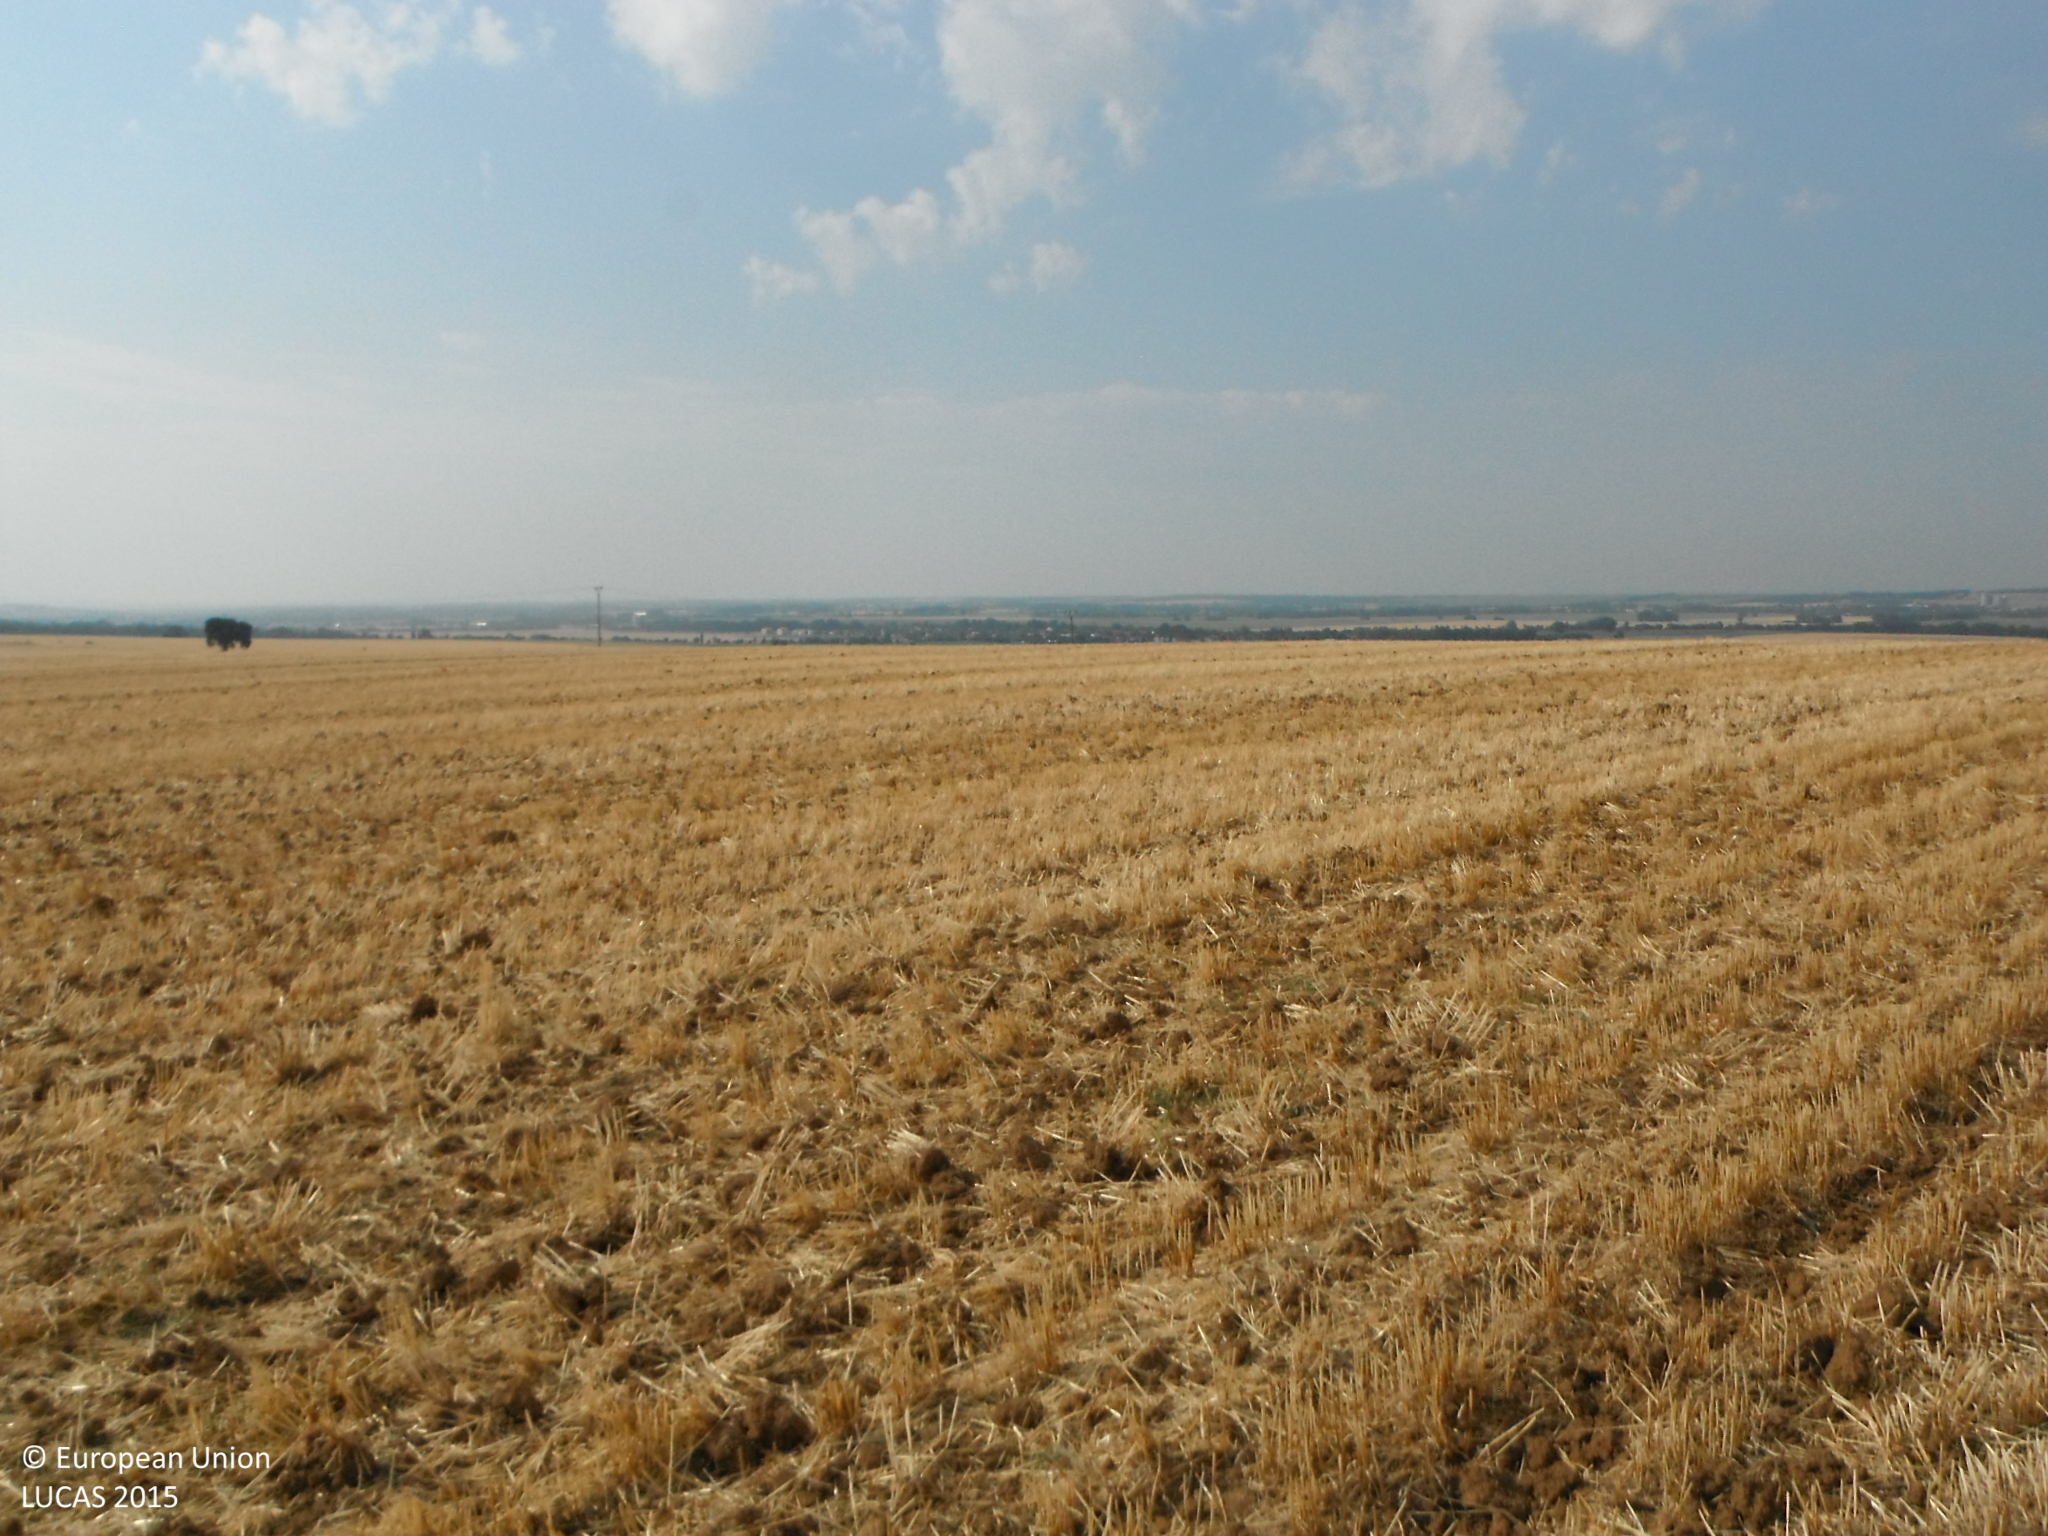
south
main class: Cropland
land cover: Barley
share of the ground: 25 - 50 %
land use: Agriculture (excluding fallow land and kitchen gardens)
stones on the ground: < 10 %
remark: Harvested field
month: August
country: SK
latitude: 48.2819
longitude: 18.1671
